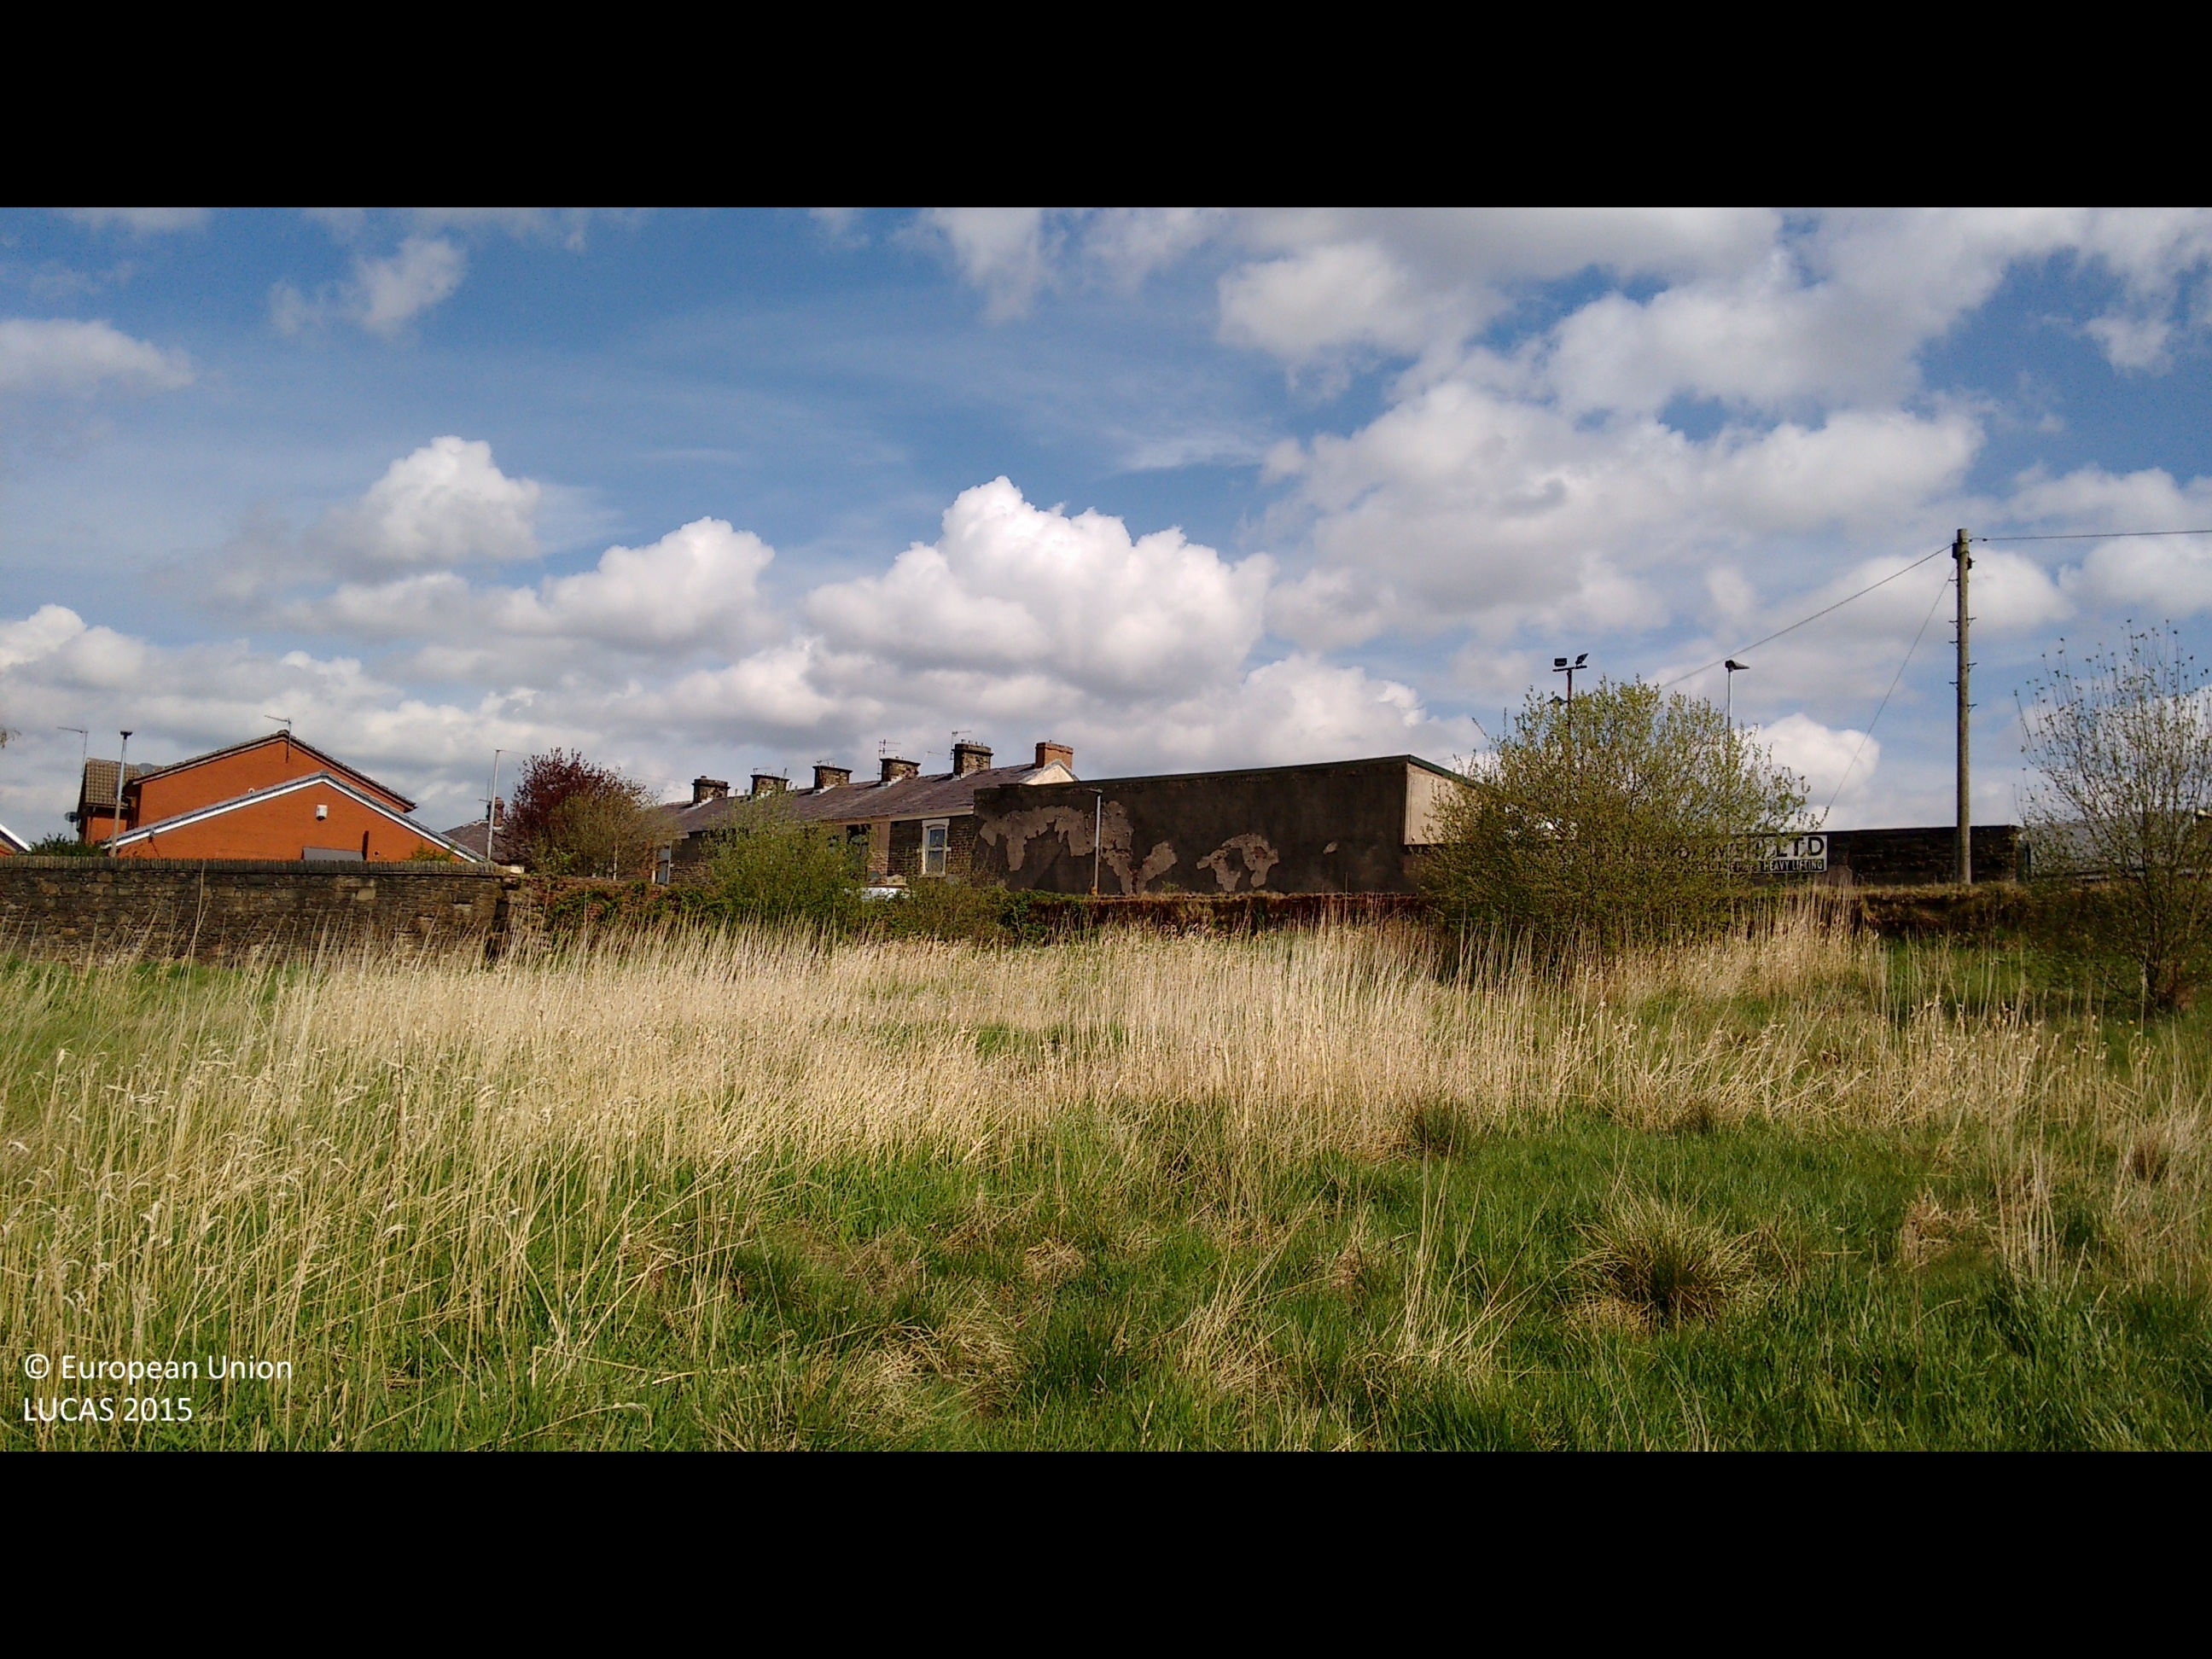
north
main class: Grassland
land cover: Grassland without tree/shrub cover
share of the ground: > 75 %
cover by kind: herbaceous plants 100 %
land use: Semi-natural and natural areas not in use
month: May
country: GB
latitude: 53.7008
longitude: -2.4702
